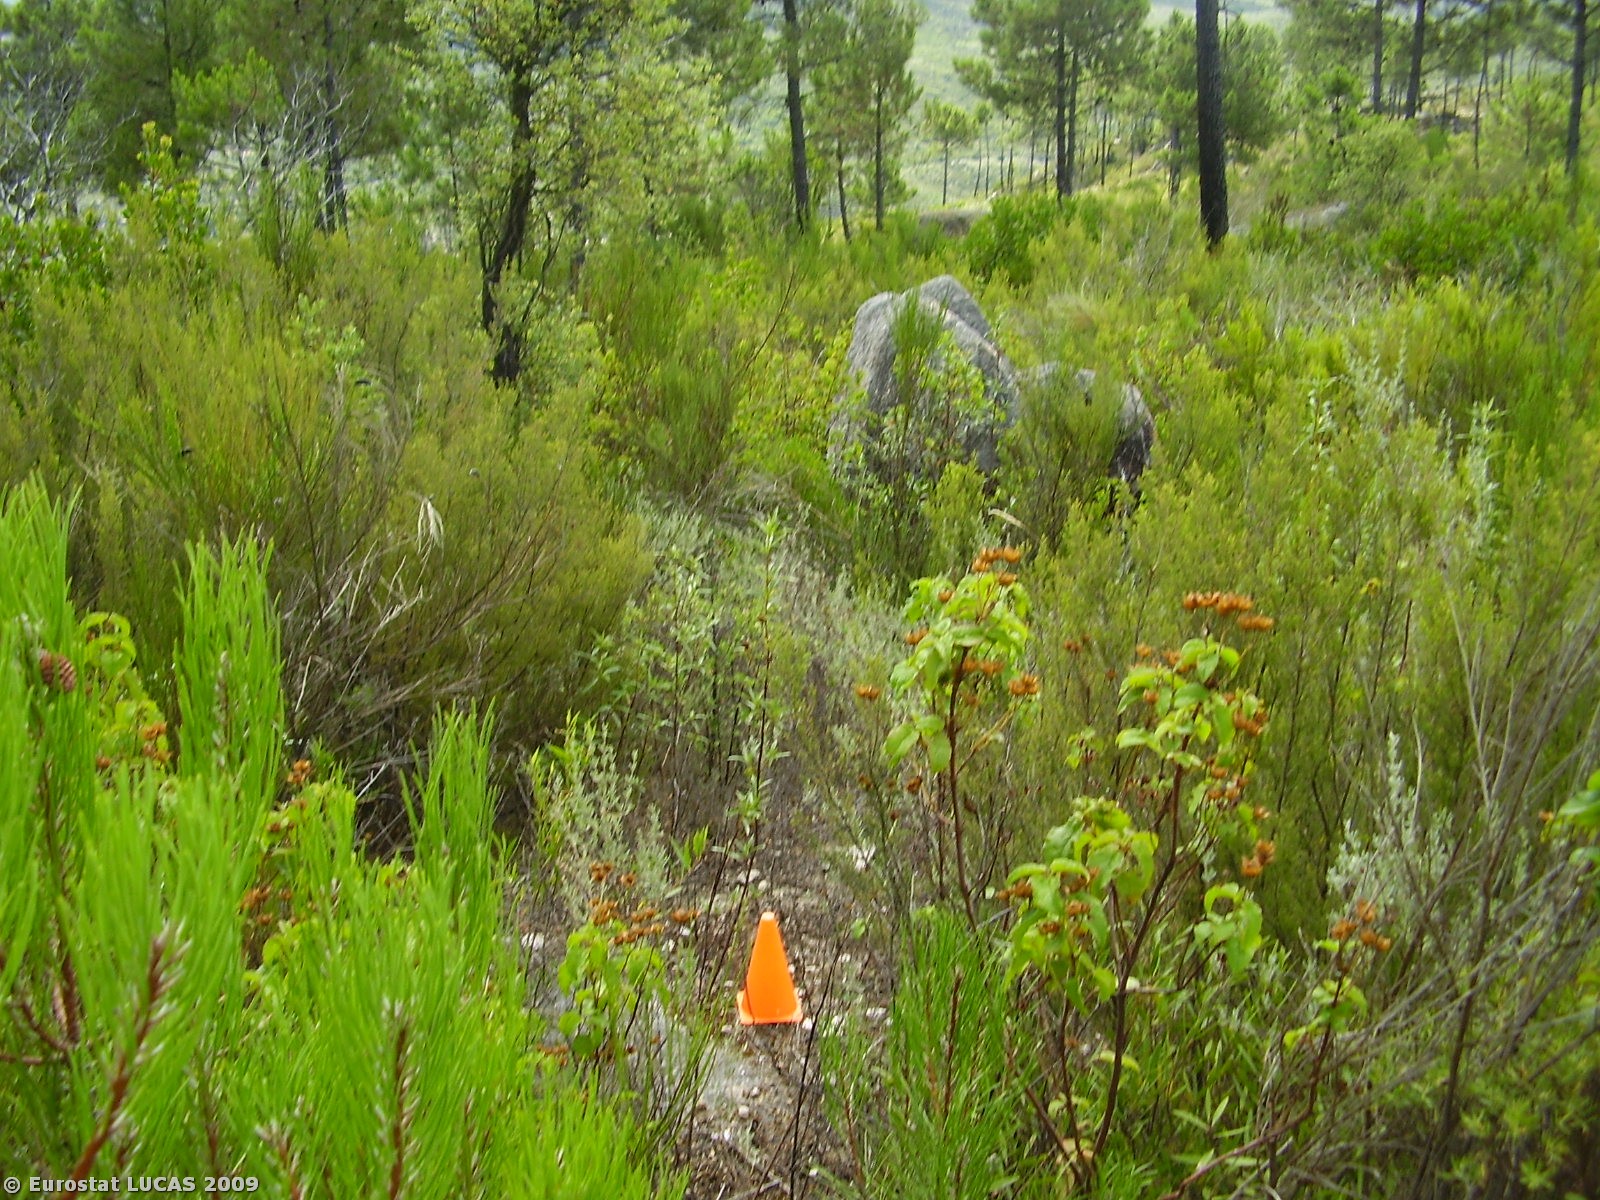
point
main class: Shrubland
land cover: Shrubland with sparse tree cover
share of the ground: > 75 %
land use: Unused
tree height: > 5 m
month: July
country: PT
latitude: 41.5986
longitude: -7.5877
